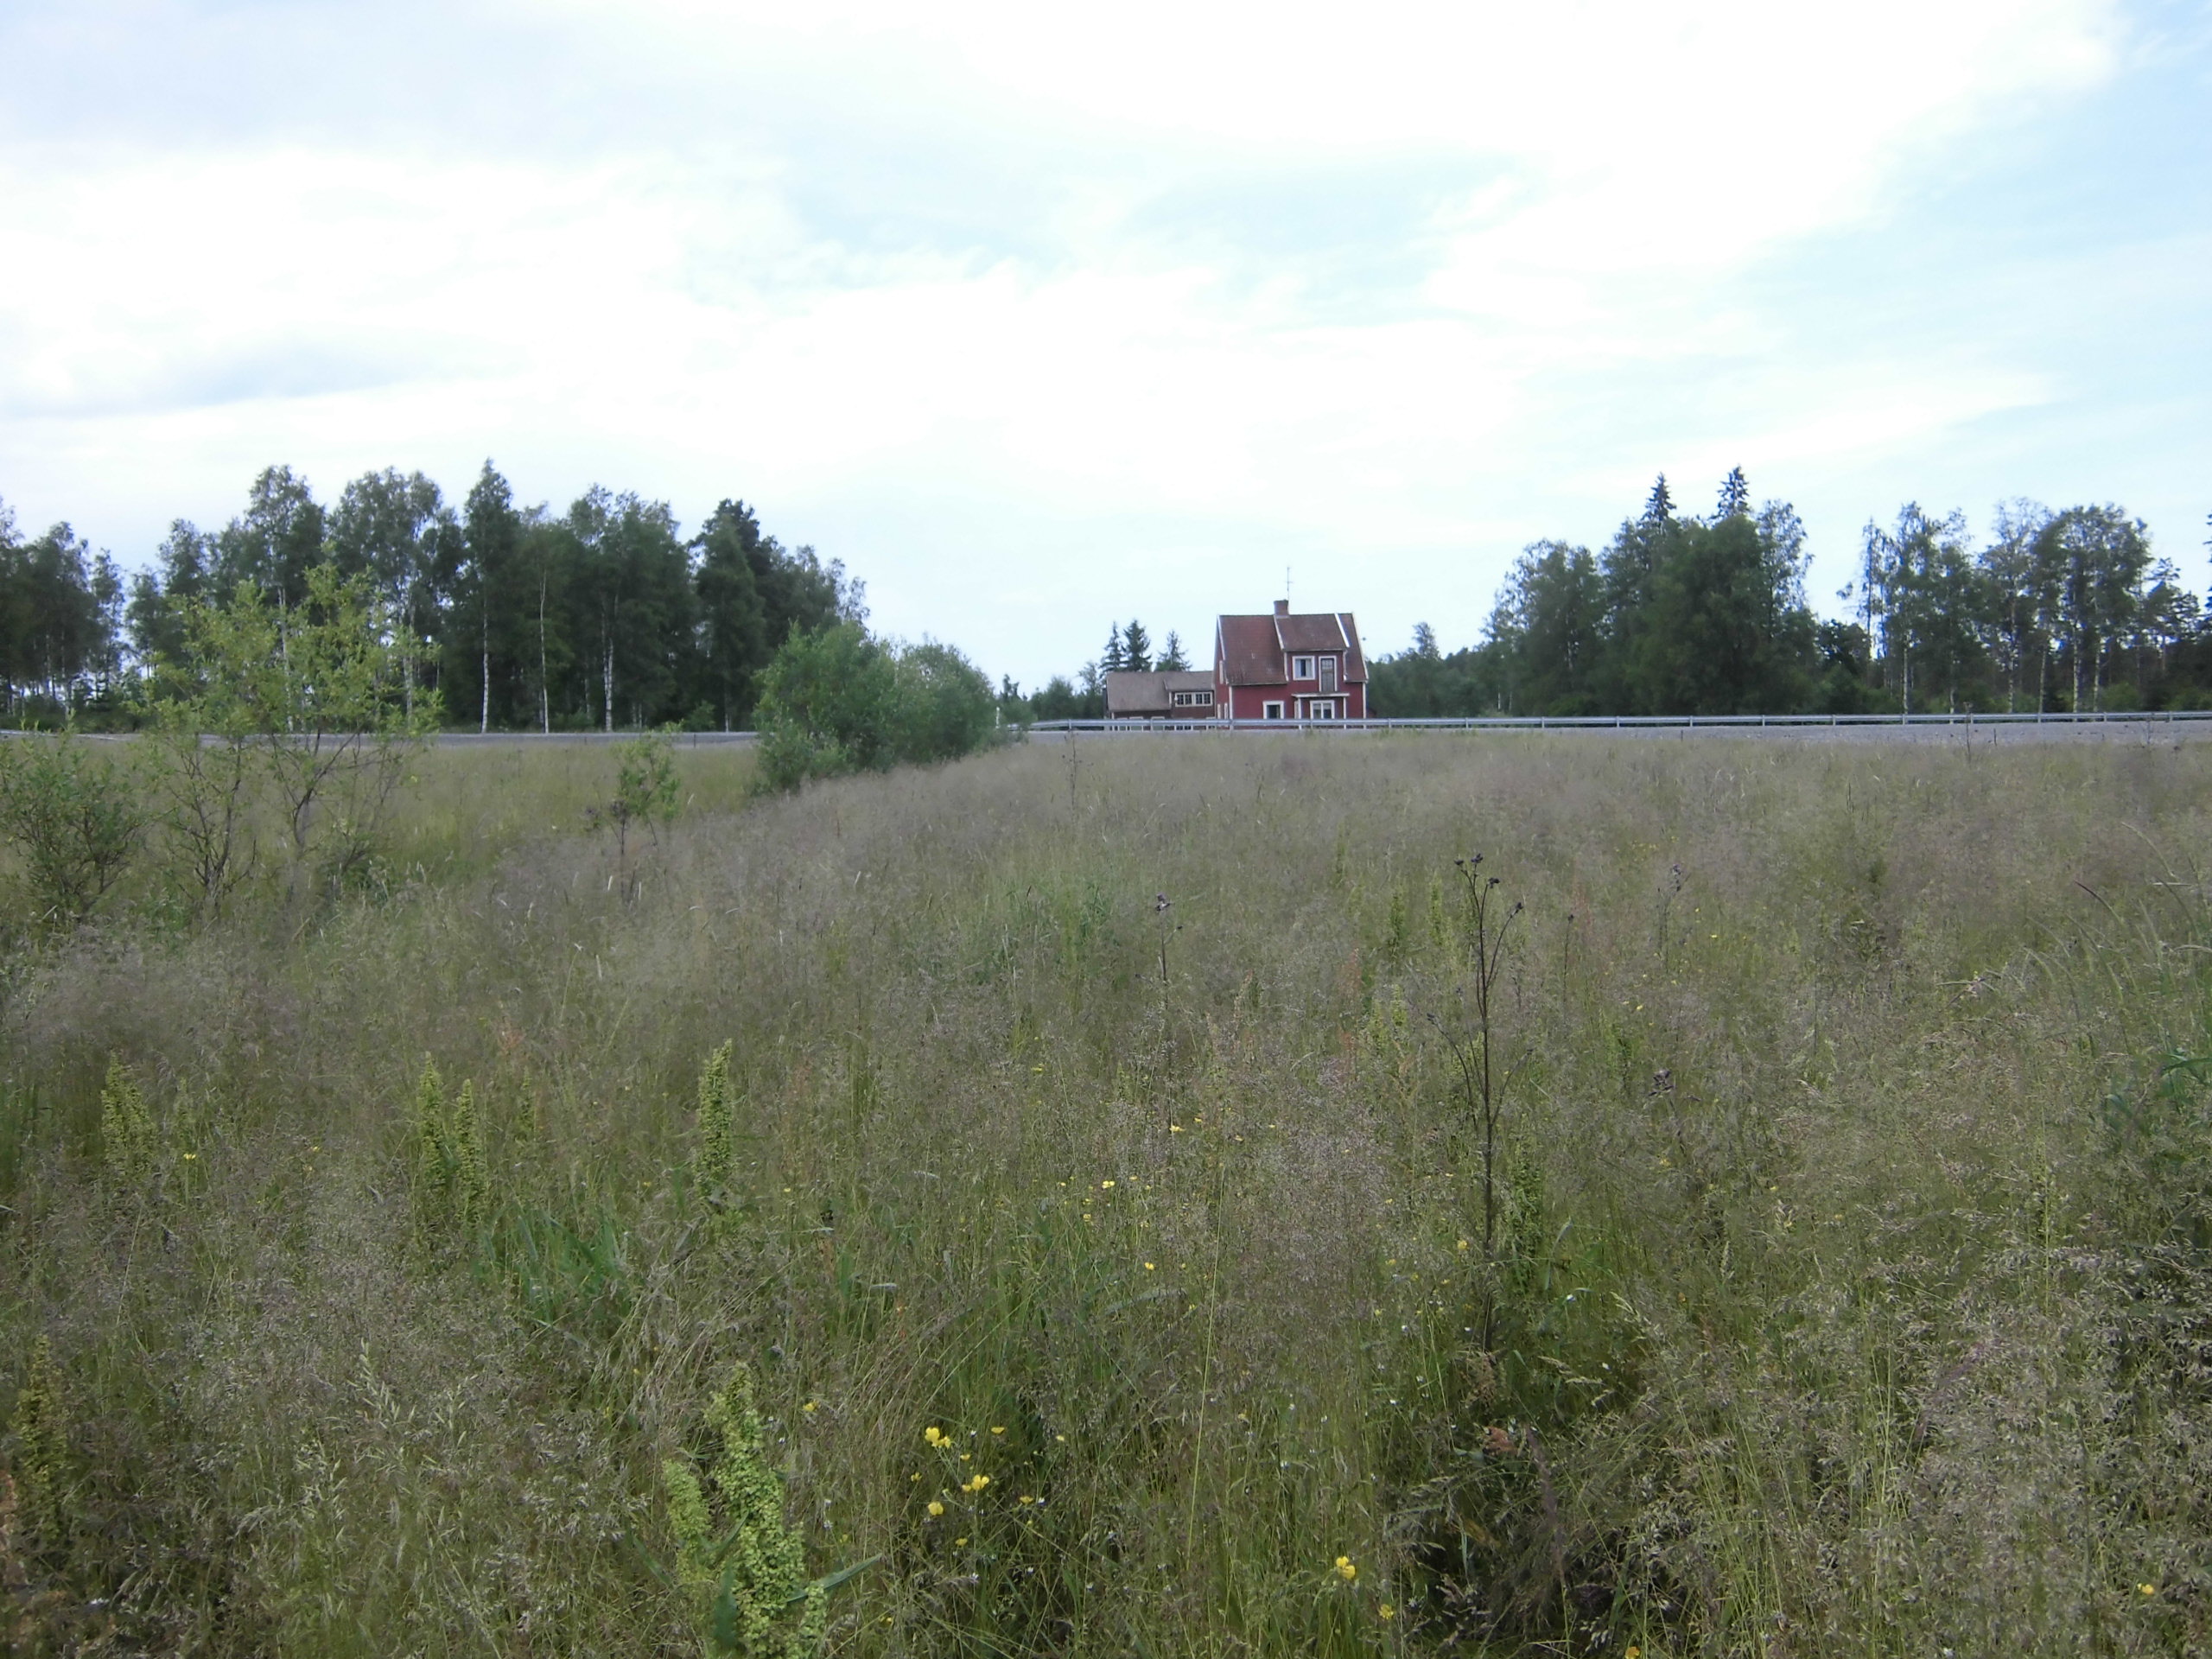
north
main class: Grassland
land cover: Grassland without tree/shrub cover
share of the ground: > 75 %
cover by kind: herbaceous plants 100 %
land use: Agriculture (excluding fallow land and kitchen gardens)
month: July
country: SE
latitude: 57.3134
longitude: 14.5618
